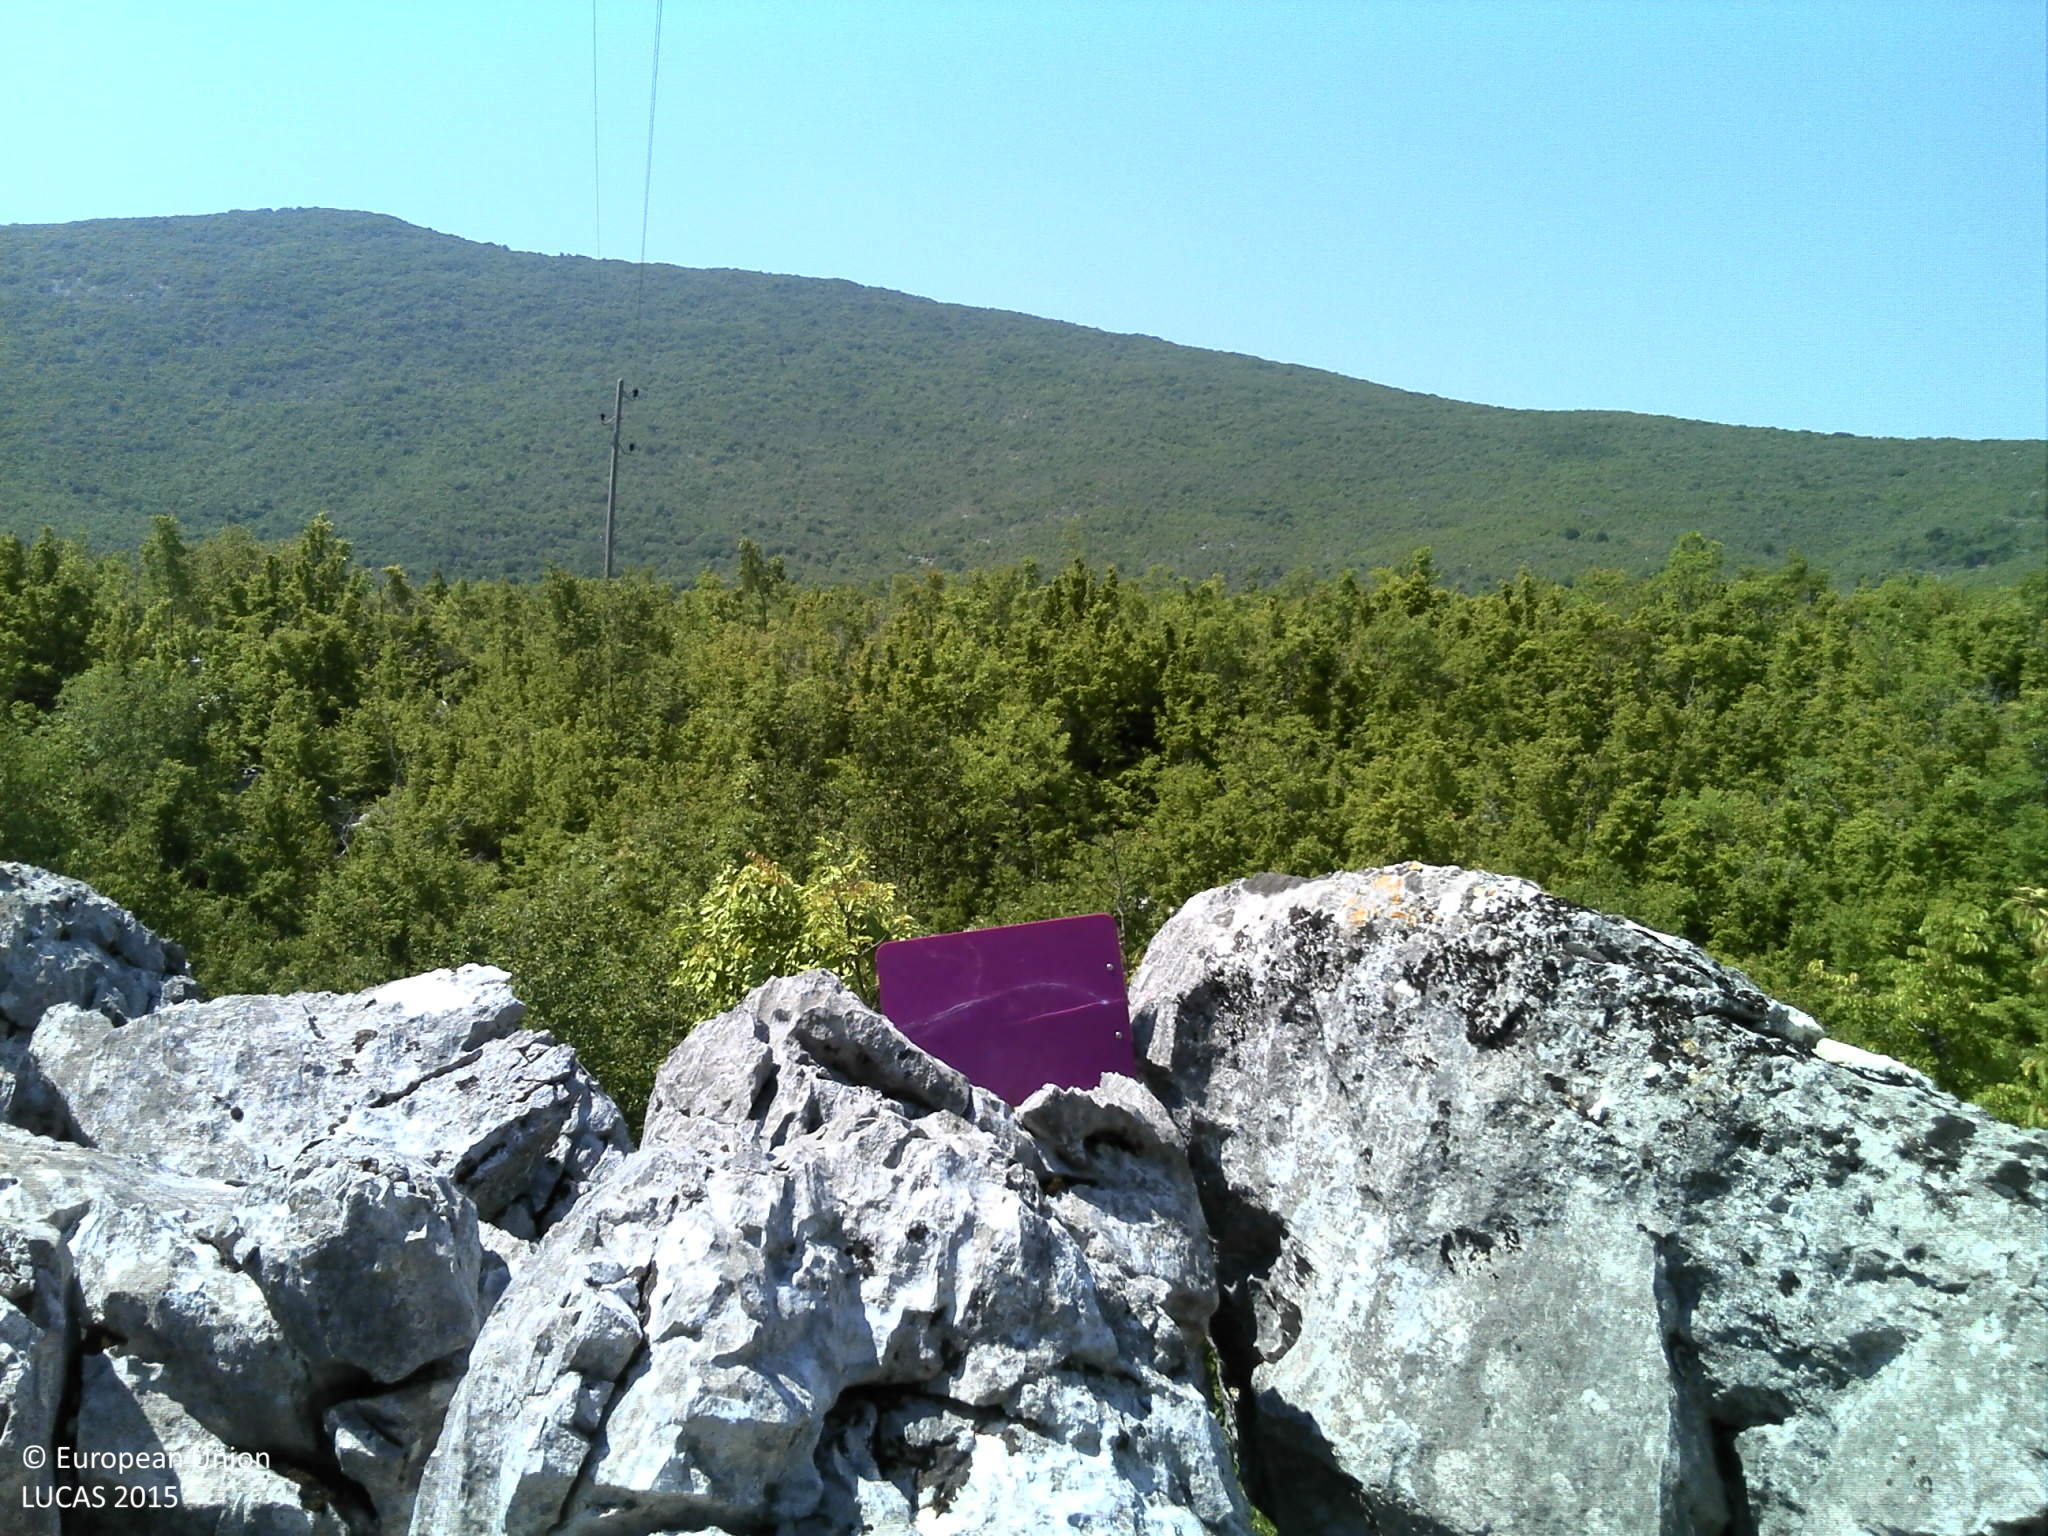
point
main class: Shrubland
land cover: Shrubland with sparse tree cover
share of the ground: > 75 %
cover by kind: shrubs 75 %, consolidated bare surface 10 %, broadleaved forest trees 5 %, herbaceous plants 5 %, unconsolidated bare surface 5 %
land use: Semi-natural and natural areas not in use
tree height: > 5 m
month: July
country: HR
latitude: 43.4624
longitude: 16.9995
